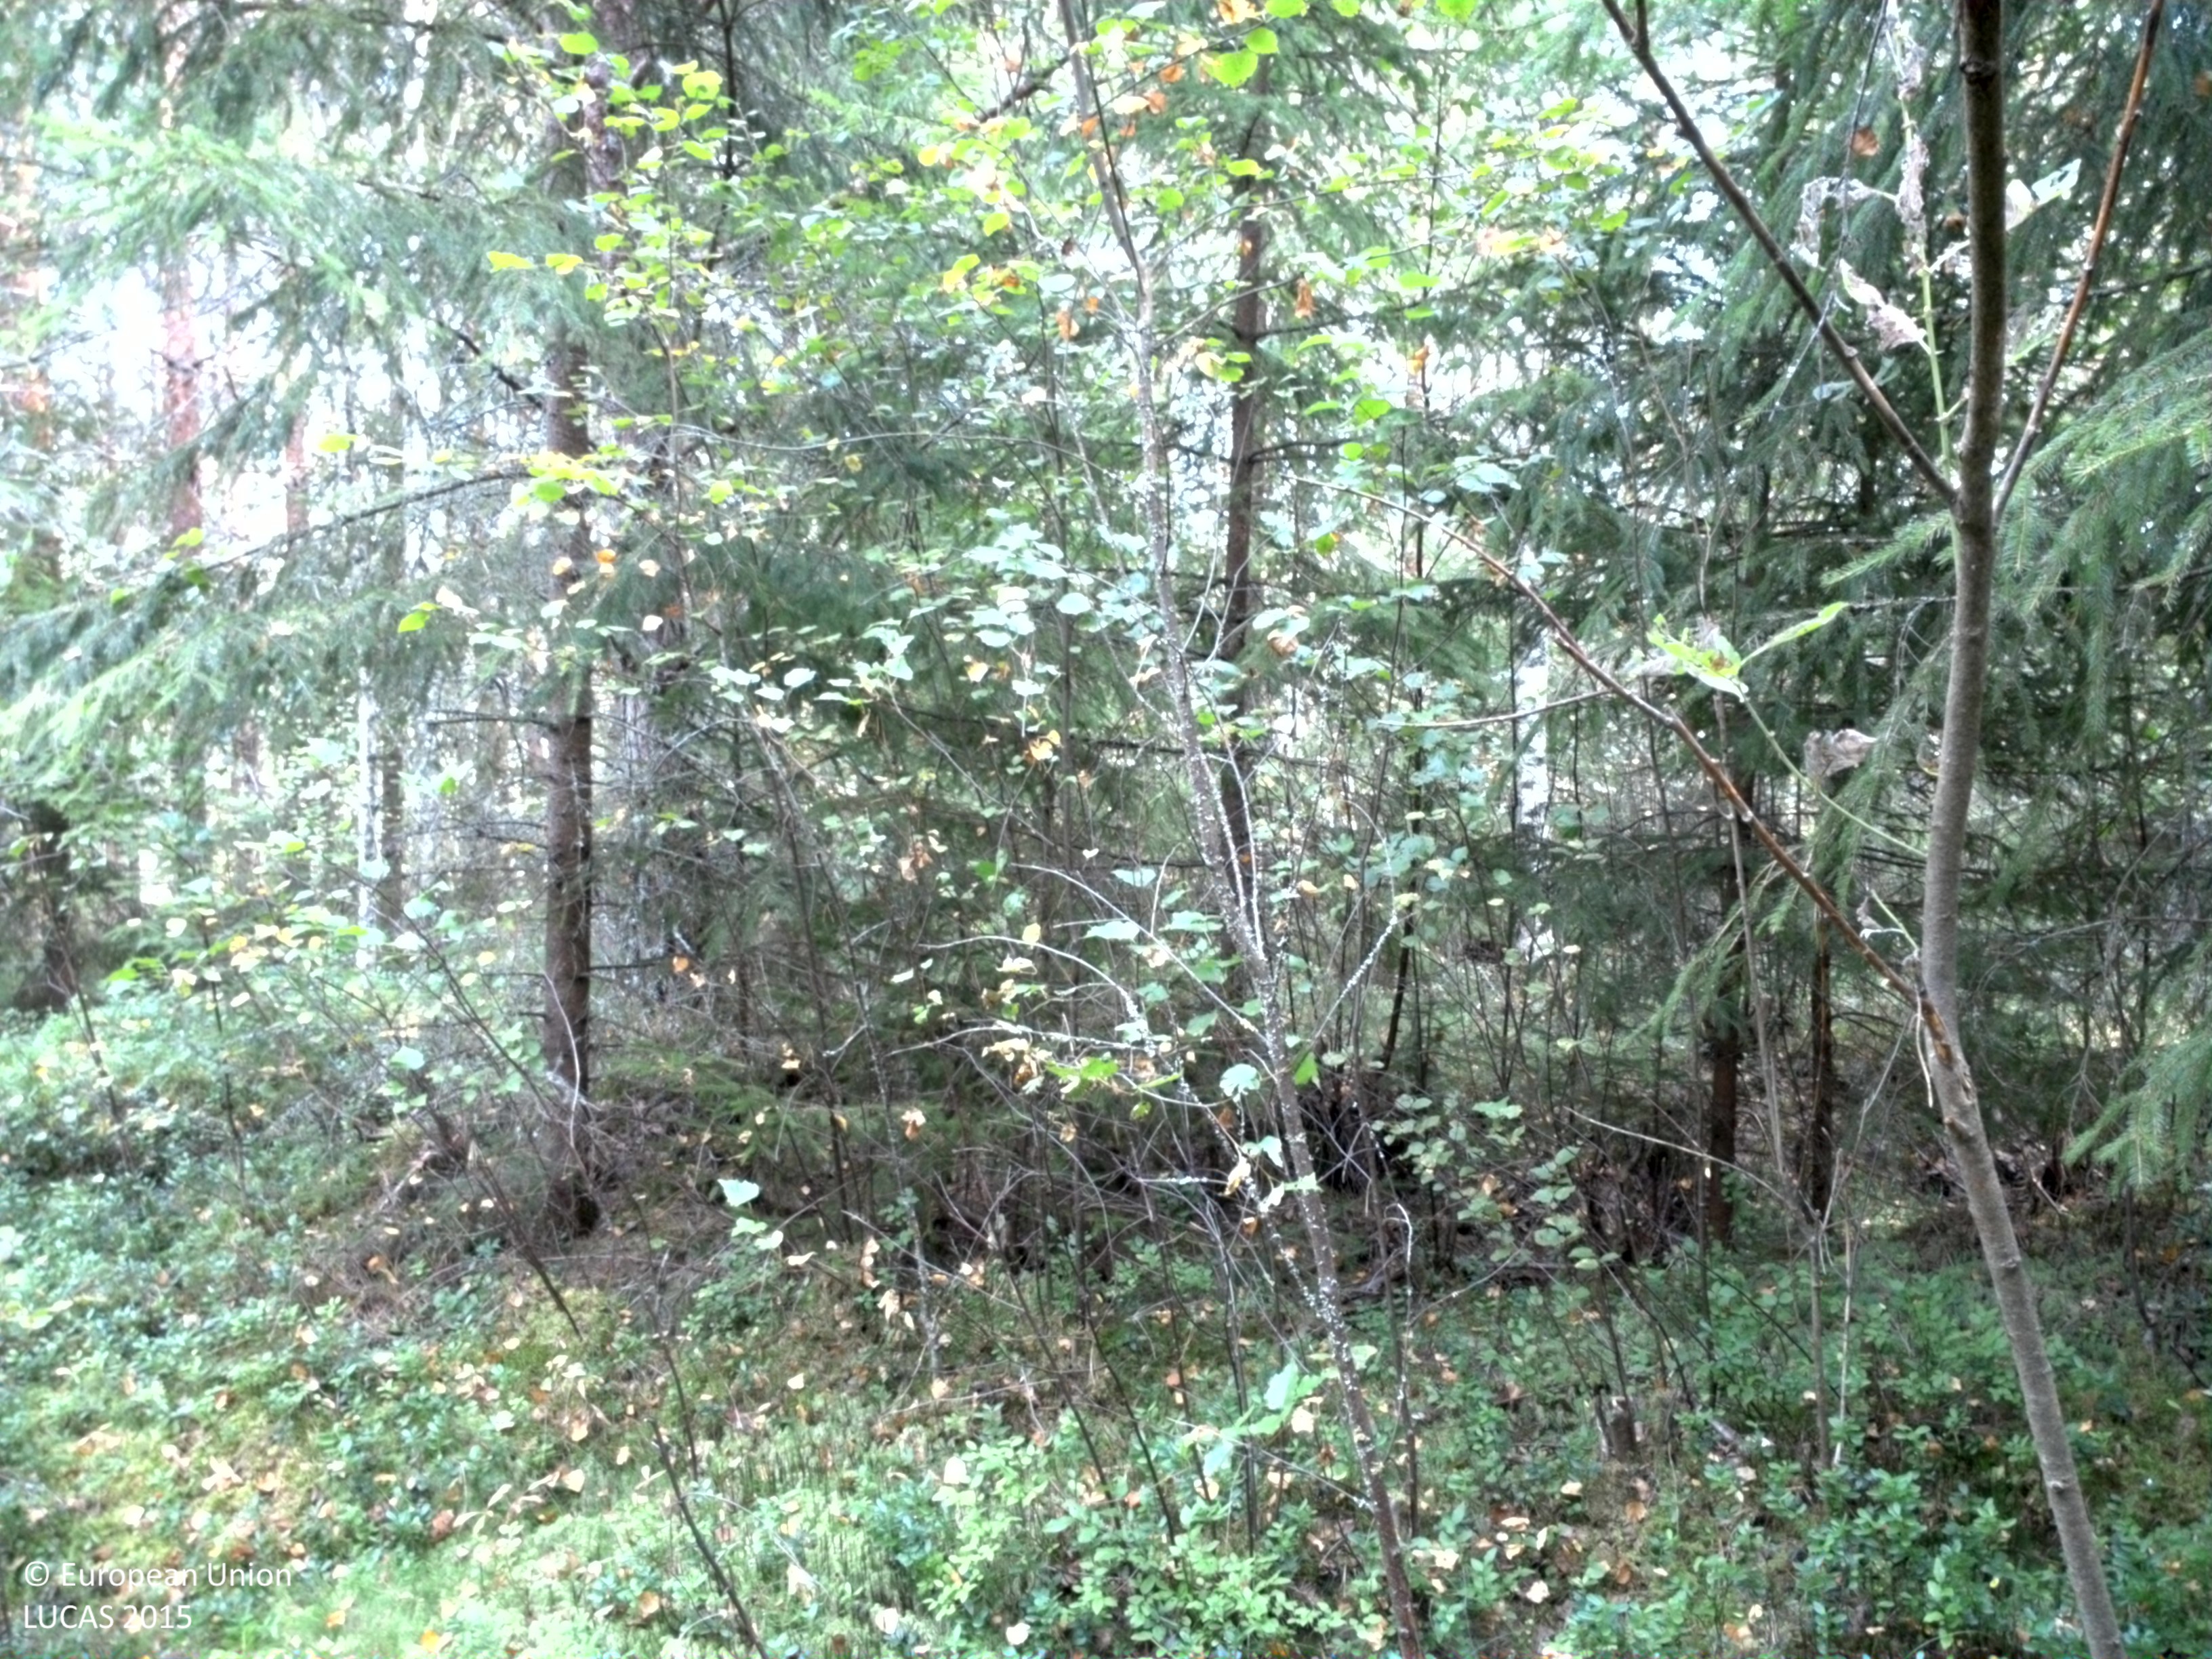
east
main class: Woodland
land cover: Pine dominated mixed woodland
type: boreal forest
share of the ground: 50 - 75 %
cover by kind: coniferous forest trees 55 %, broadleaved forest trees 20 %, lichens and mosses 20 %, shrubs 5 %
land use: Forestry
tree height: > 5 m
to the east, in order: Pine dominated mixed woodland; Ditches and canals; Paved roads, cycling and walking lanes; Ditches and canals; Pine dominated coniferous woodland; Fences; Paved roads, cycling and walking lanes; Fences; Pine dominated mixed woodland; Ditches and canals; Grass margins; Paved roads, cycling and walking lanes; Grassland without tree/shrub cover; Artificial constructions in urban areas; Inland fresh running water
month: August
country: SE
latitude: 59.6160
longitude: 13.4481
